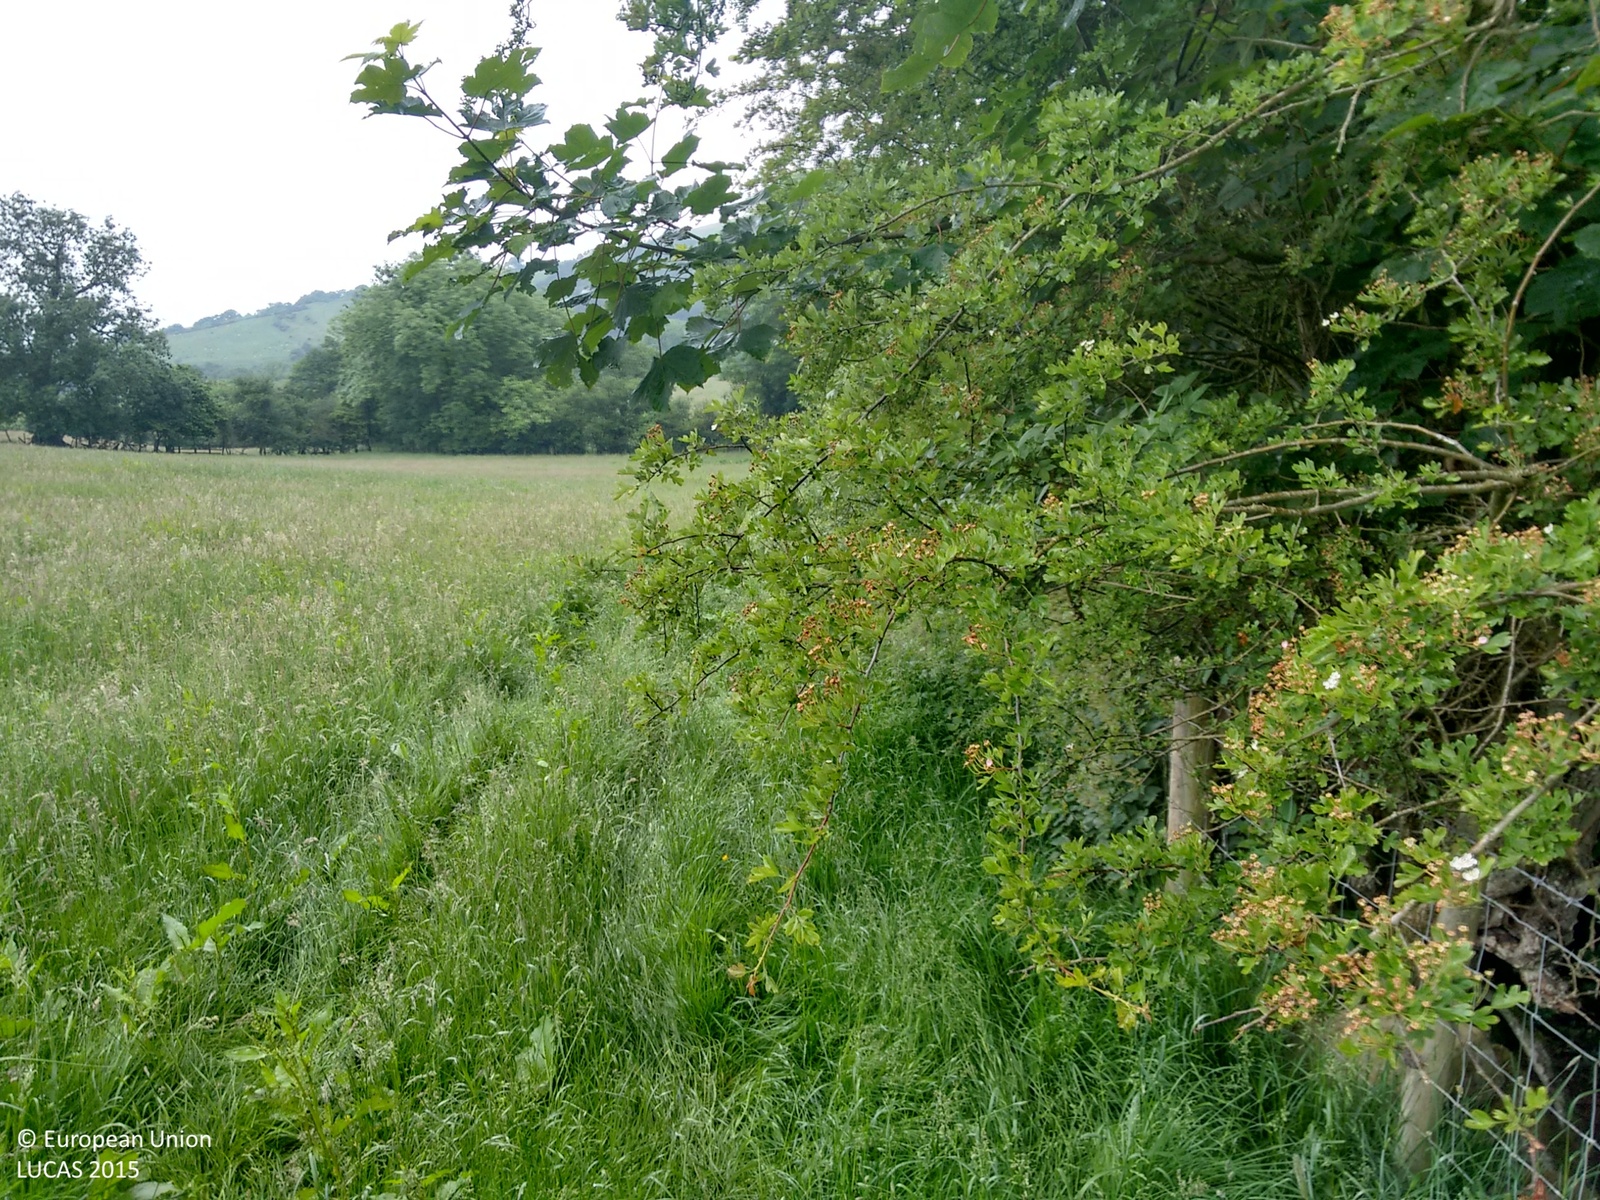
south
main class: Grassland
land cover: Grassland without tree/shrub cover
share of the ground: > 75 %
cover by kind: herbaceous plants 100 %
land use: Agriculture (excluding fallow land and kitchen gardens)
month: June
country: GB
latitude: 54.3925
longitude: -1.1480
